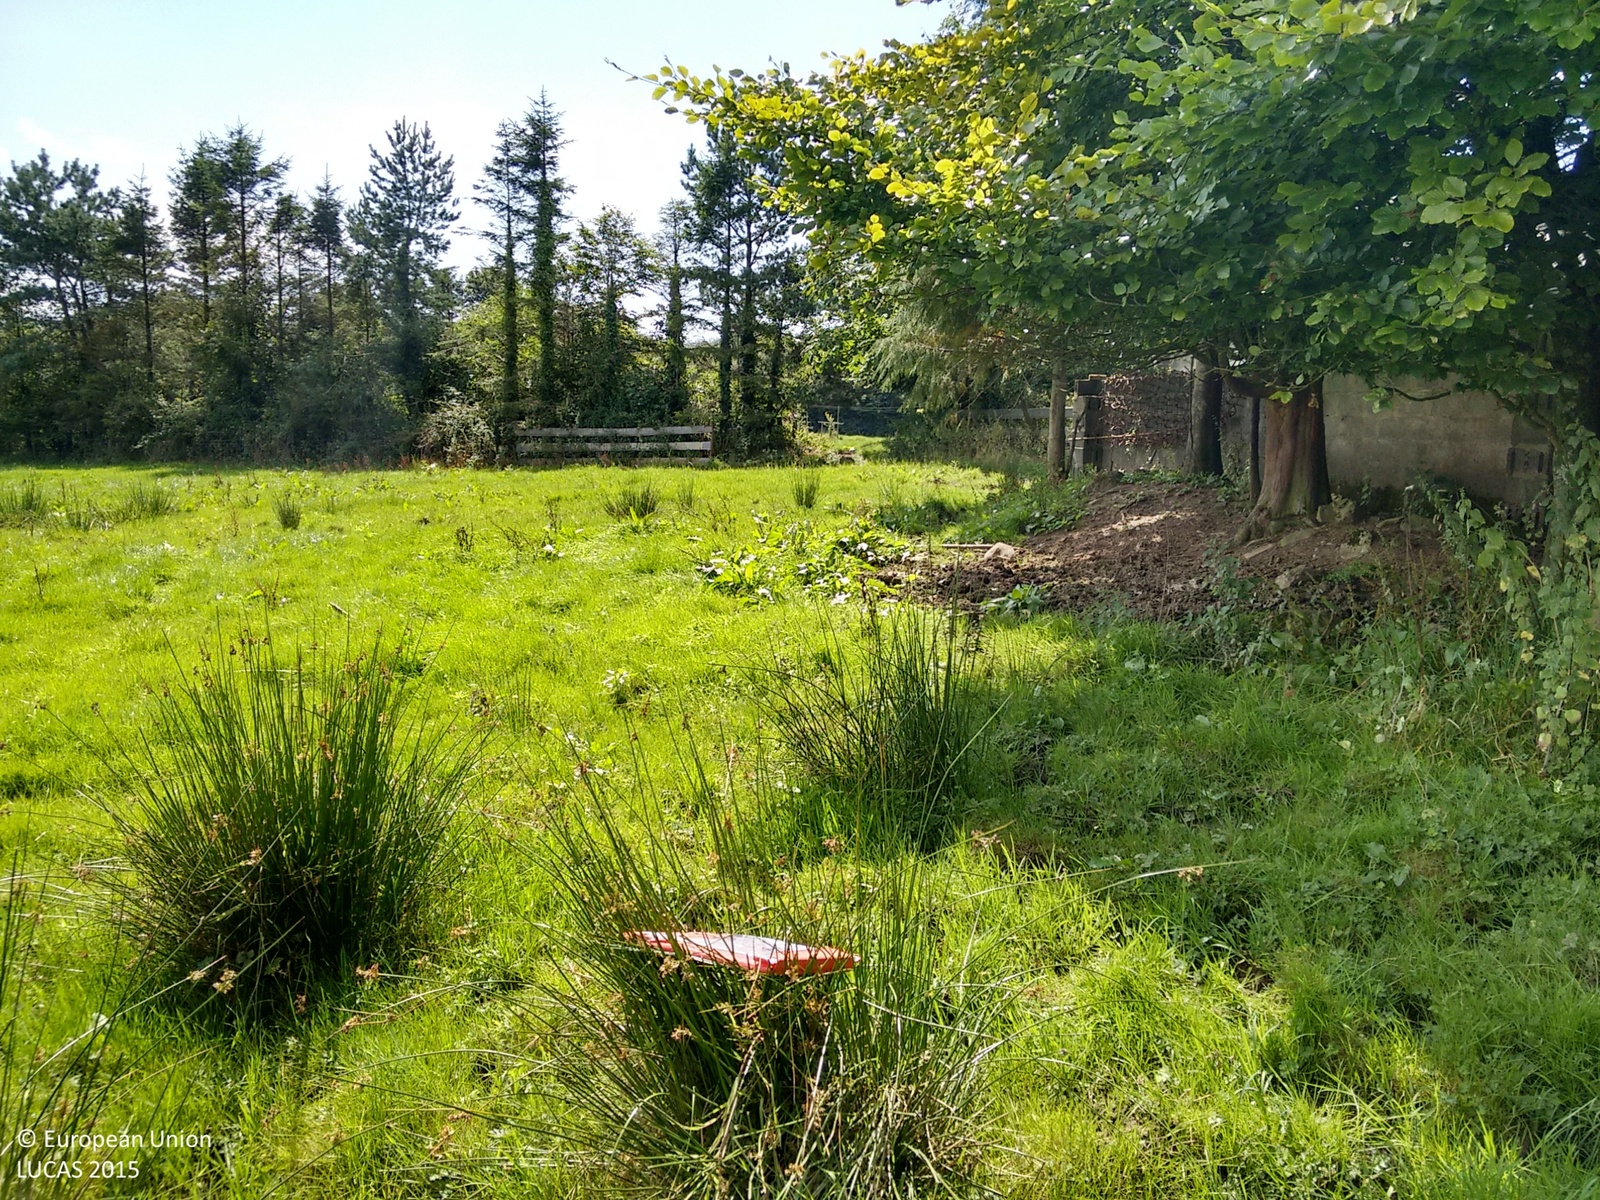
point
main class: Grassland
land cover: Grassland without tree/shrub cover
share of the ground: > 75 %
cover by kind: herbaceous plants 100 %
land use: Agriculture (excluding fallow land and kitchen gardens)
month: August
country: GB
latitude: 51.8229
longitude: -4.3940
